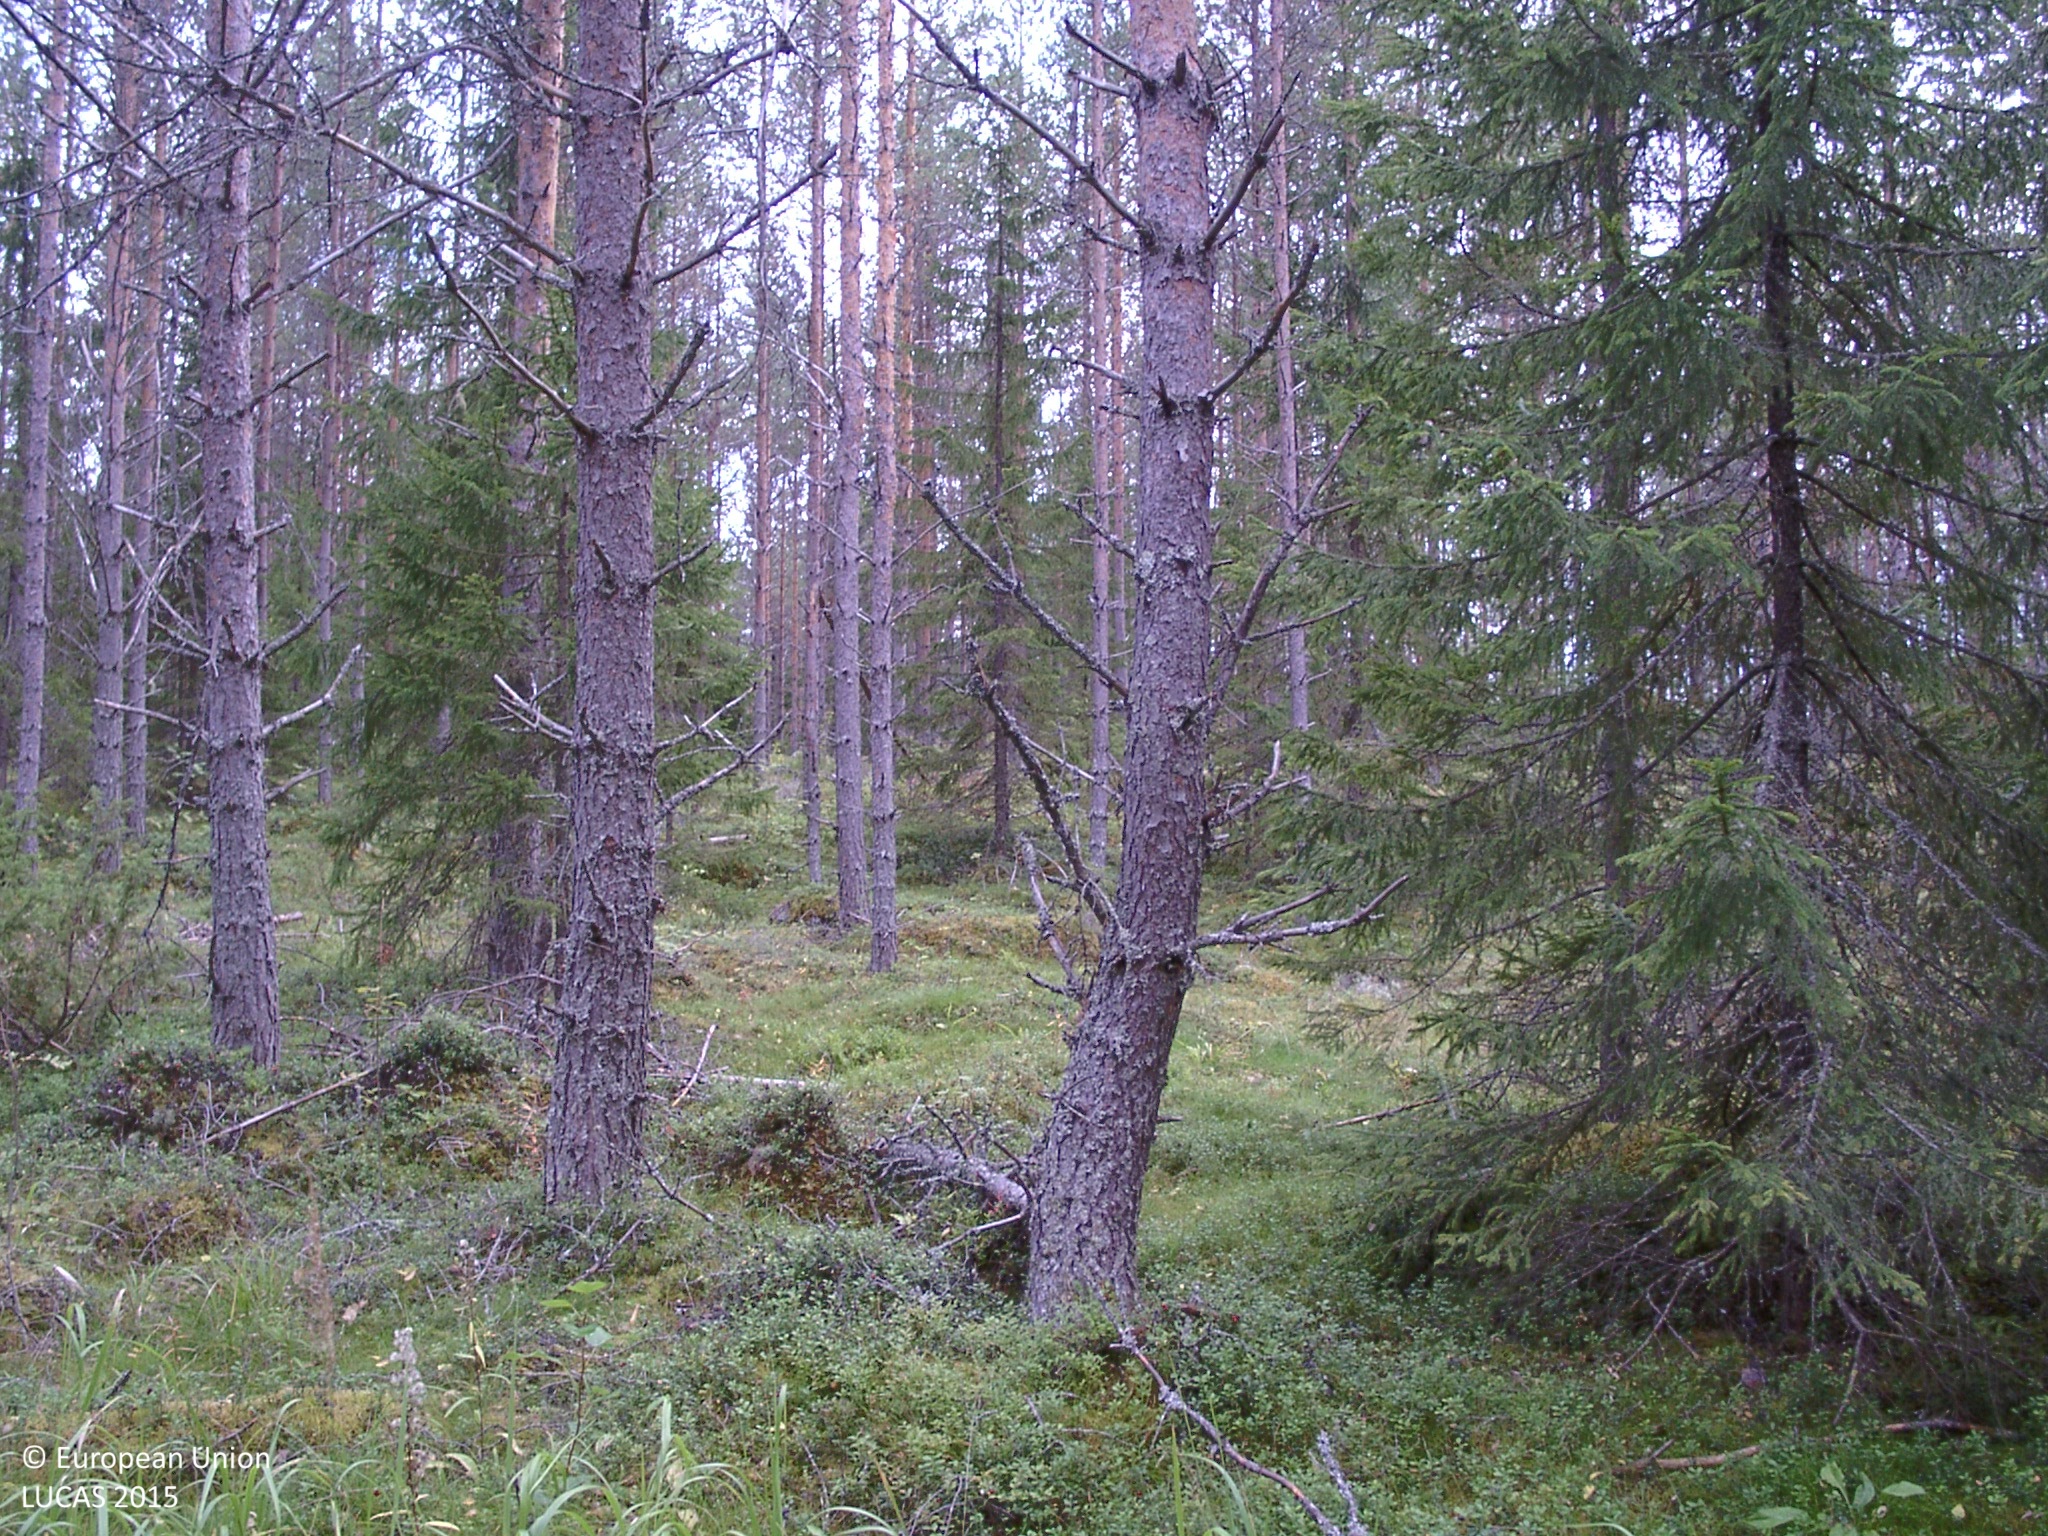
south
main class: Woodland
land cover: Other coniferous woodland
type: boreal forest
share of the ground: 50 - 75 %
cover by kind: coniferous forest trees 50 %, herbaceous plants 30 %, shrubs 10 %, lichens and mosses 10 %
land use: Forestry
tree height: > 5 m
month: September
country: FI
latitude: 62.8820
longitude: 25.5859
